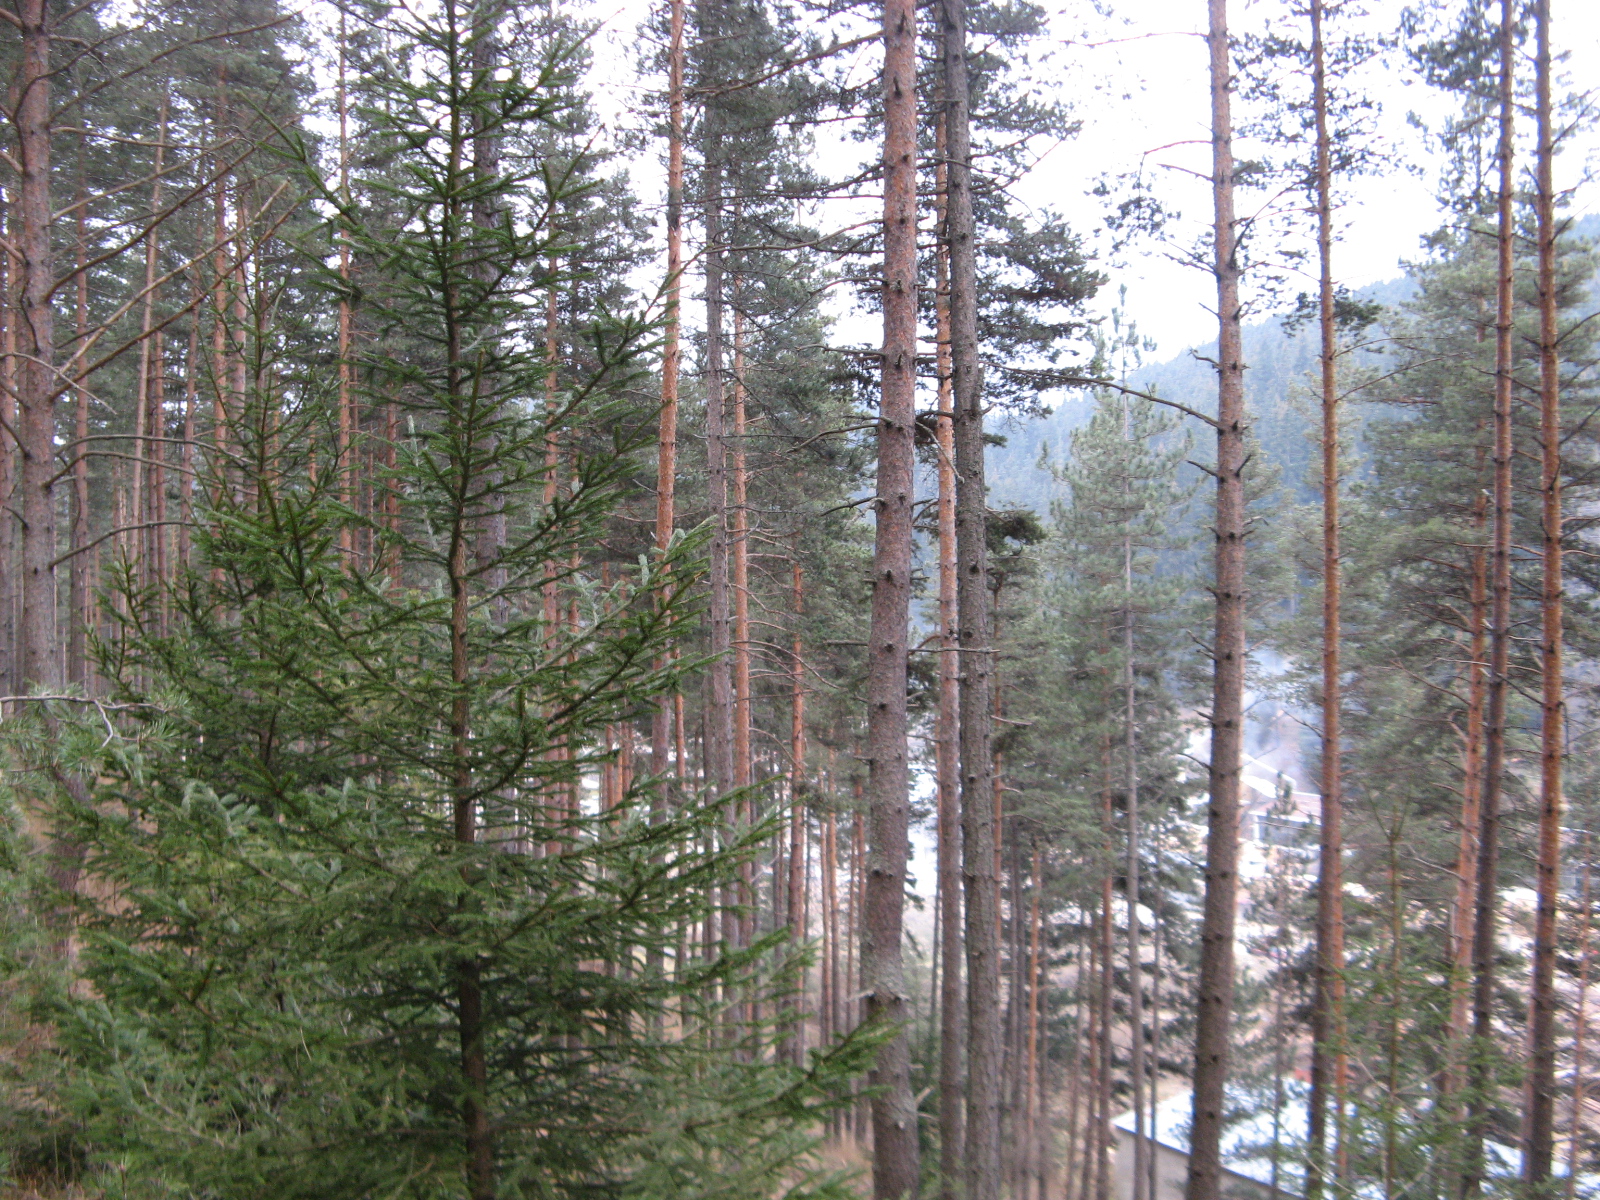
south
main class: Woodland
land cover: Pine dominated coniferous woodland
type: hemiboreal forest and nemoral coniferous forest and mixed broadleaved-coniferous forest
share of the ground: > 75 %
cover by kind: coniferous forest trees 85 %, herbaceous plants 5 %, lichens and mosses 5 %, unconsolidated bare surface 5 %
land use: Forestry
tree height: > 5 m
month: December
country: BG
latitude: 41.6345
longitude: 24.1647
